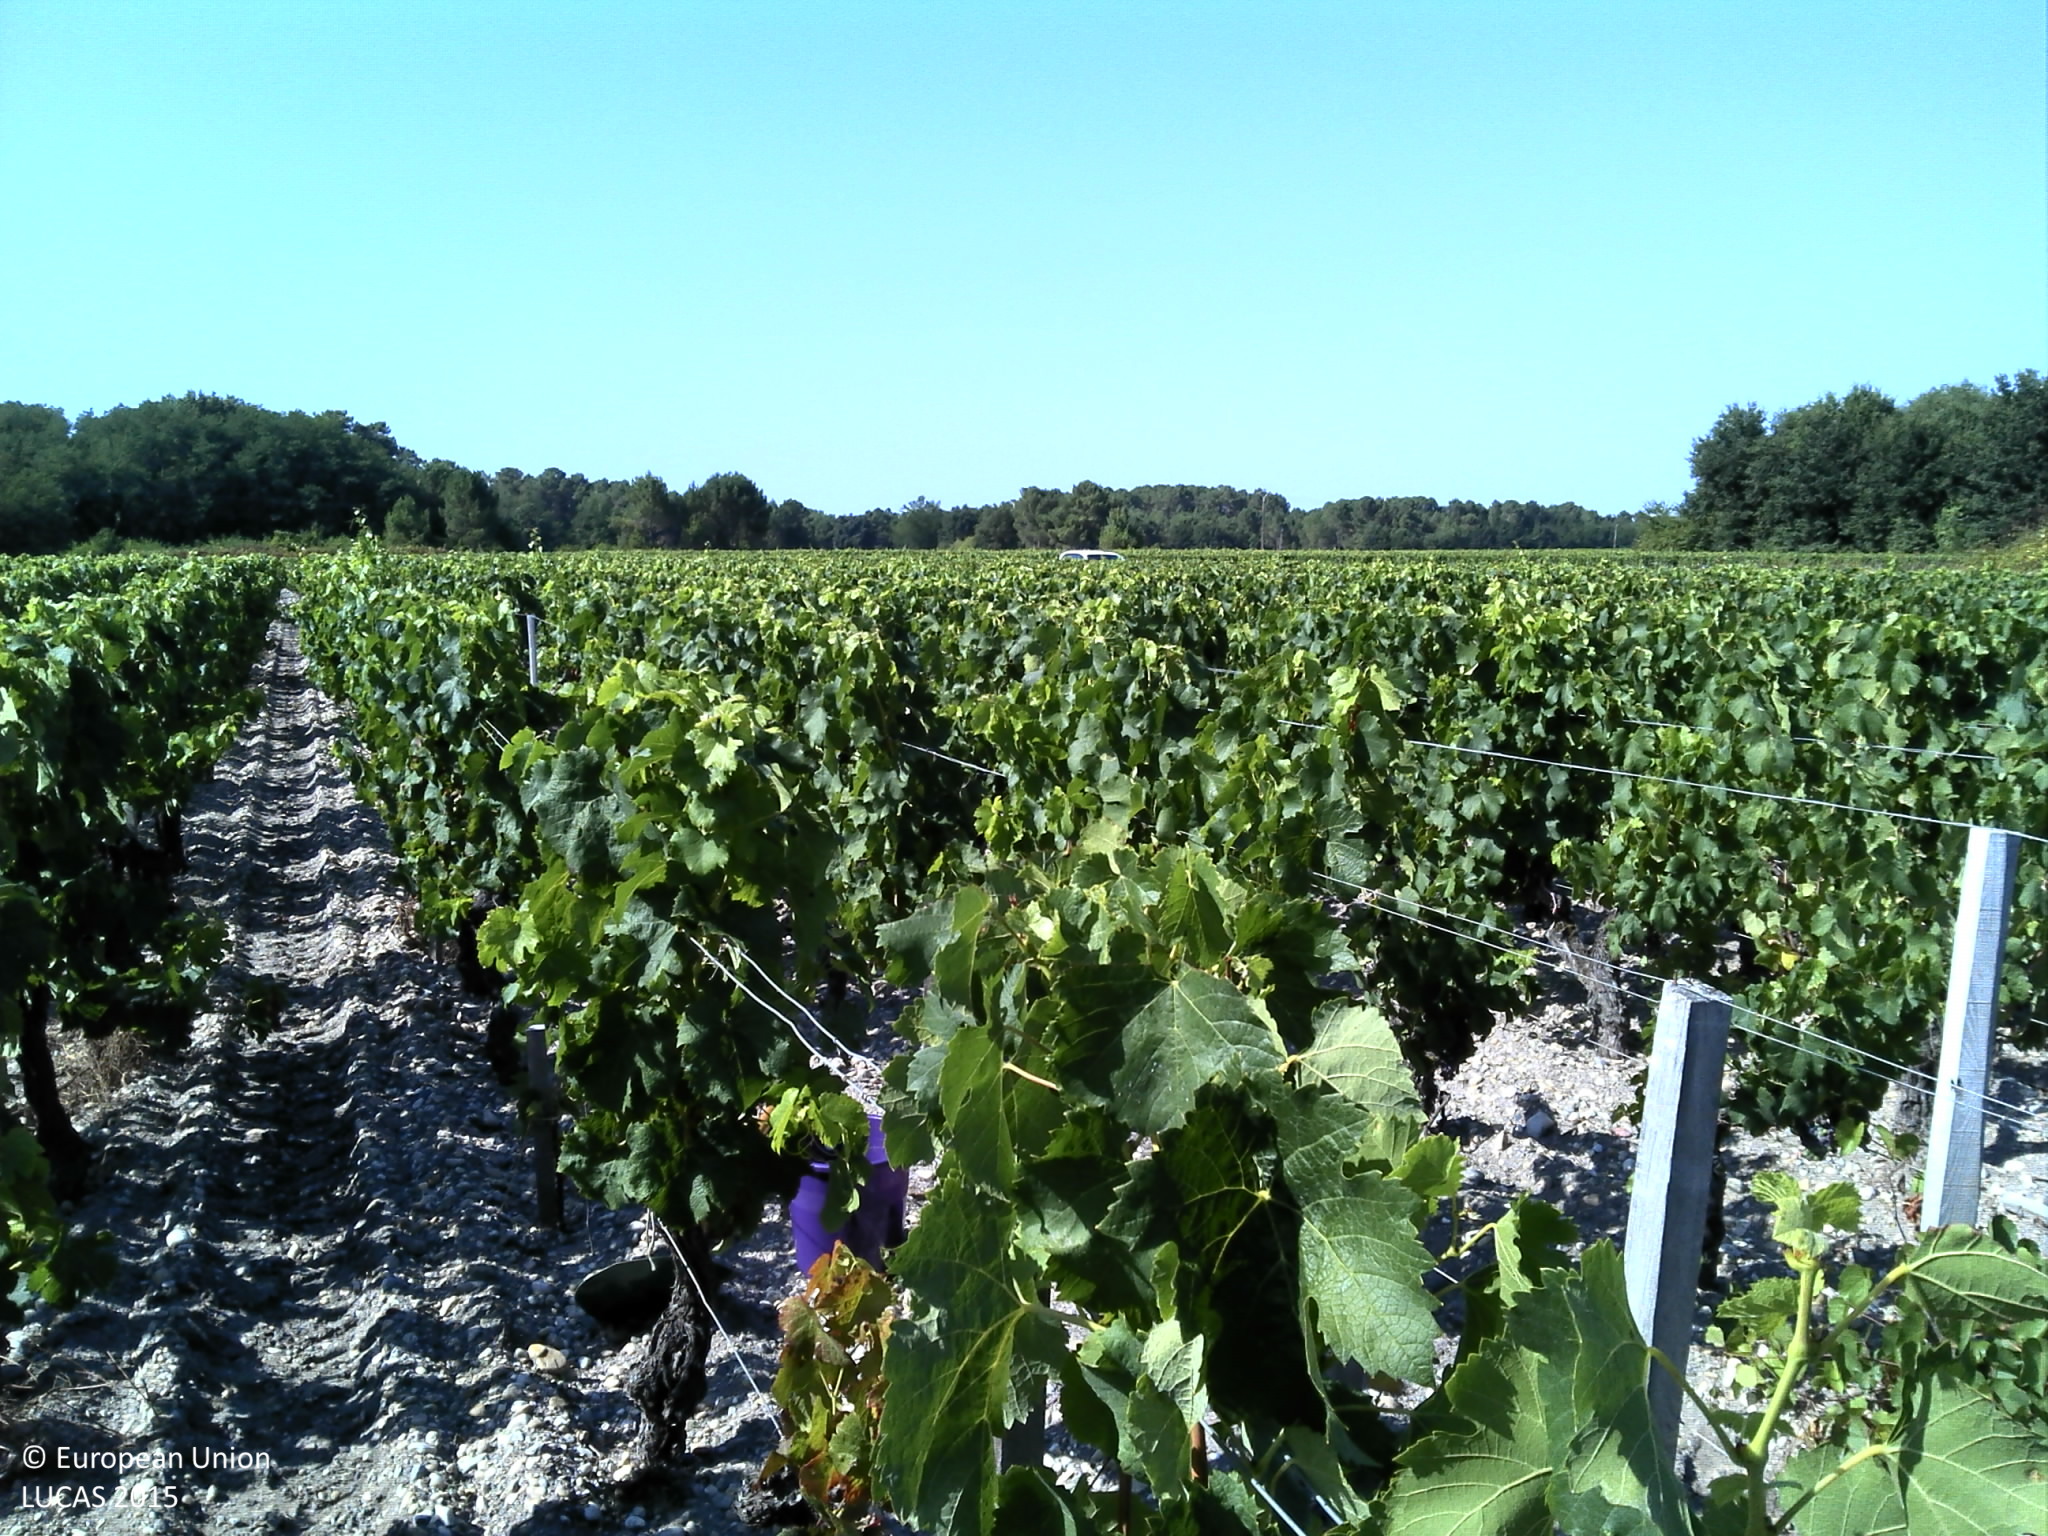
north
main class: Cropland
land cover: Vineyards
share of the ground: 25 - 50 %
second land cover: Other bare soil
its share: > 75 %
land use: Agriculture (excluding fallow land and kitchen gardens)
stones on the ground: 25 - 50 %
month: August
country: FR
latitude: 45.0804
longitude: -0.7563
